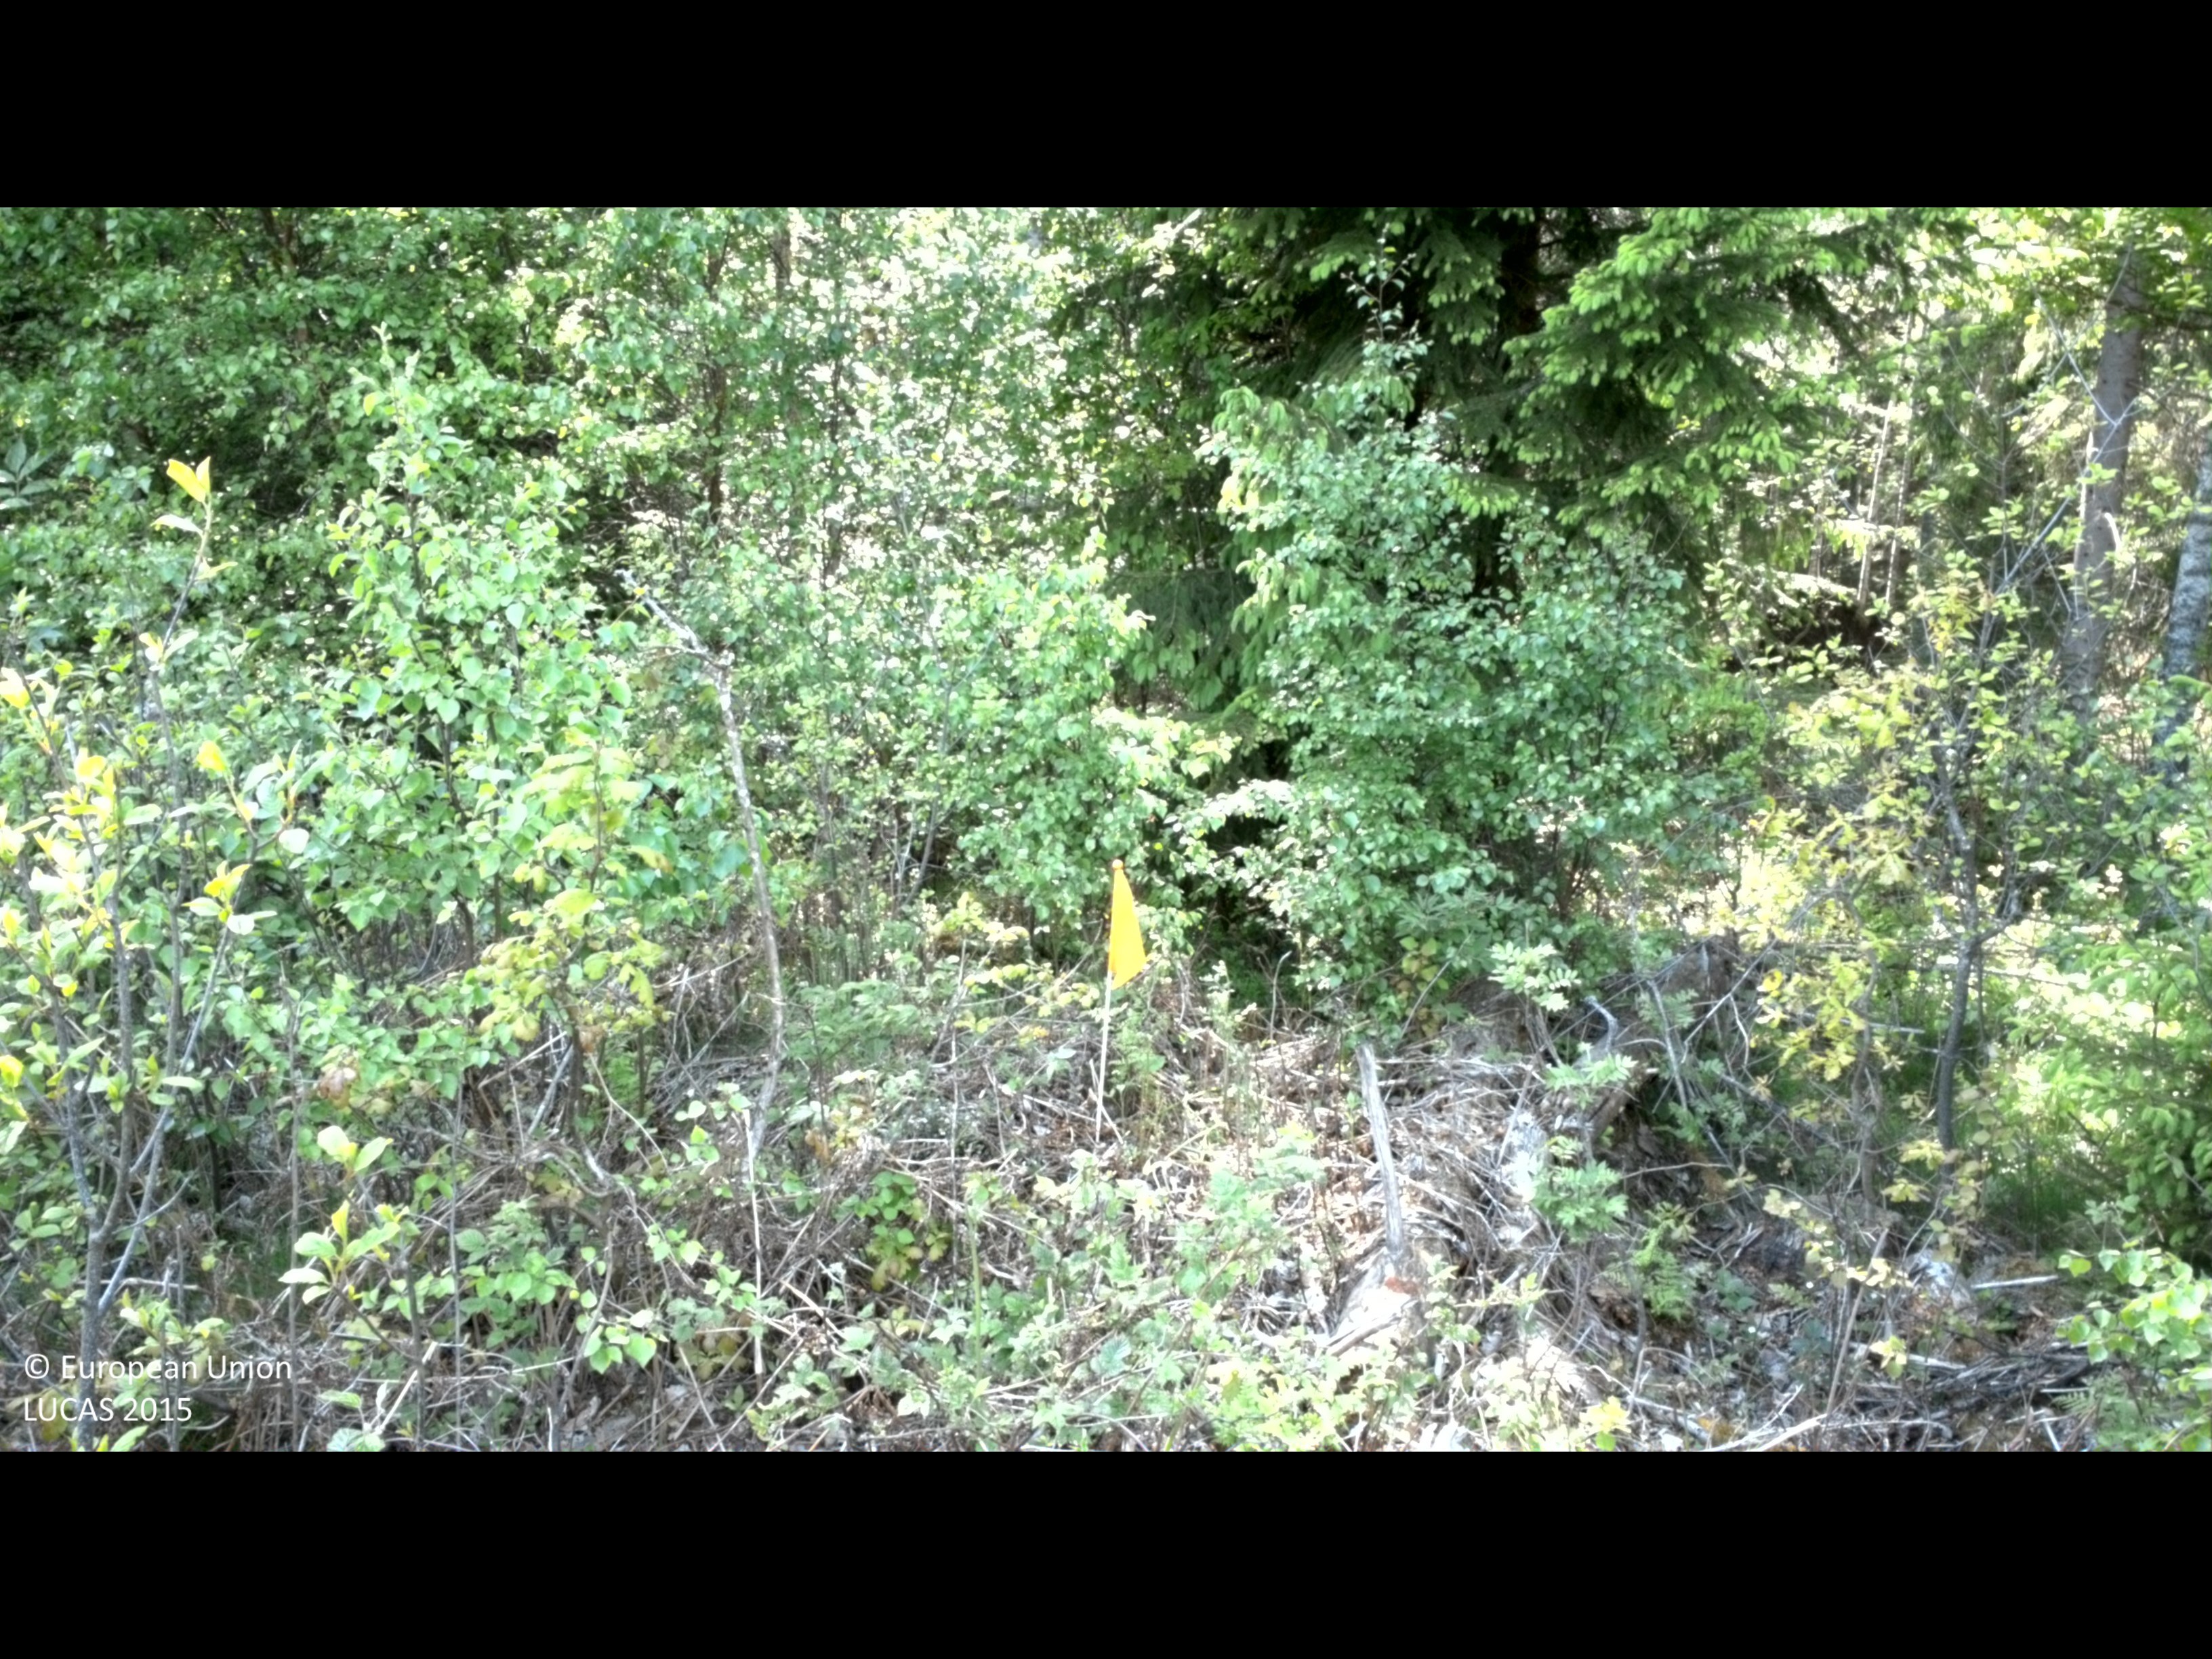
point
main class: Woodland
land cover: Broadleaved woodland
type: hemiboreal forest and nemoral coniferous forest and mixed broadleaved-coniferous forest
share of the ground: 25 - 50 %
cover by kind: shrubs 60 %, broadleaved forest trees 25 %, herbaceous plants 10 %
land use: Forestry
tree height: < 5 m
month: June
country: SE
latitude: 57.8055
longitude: 16.2070
